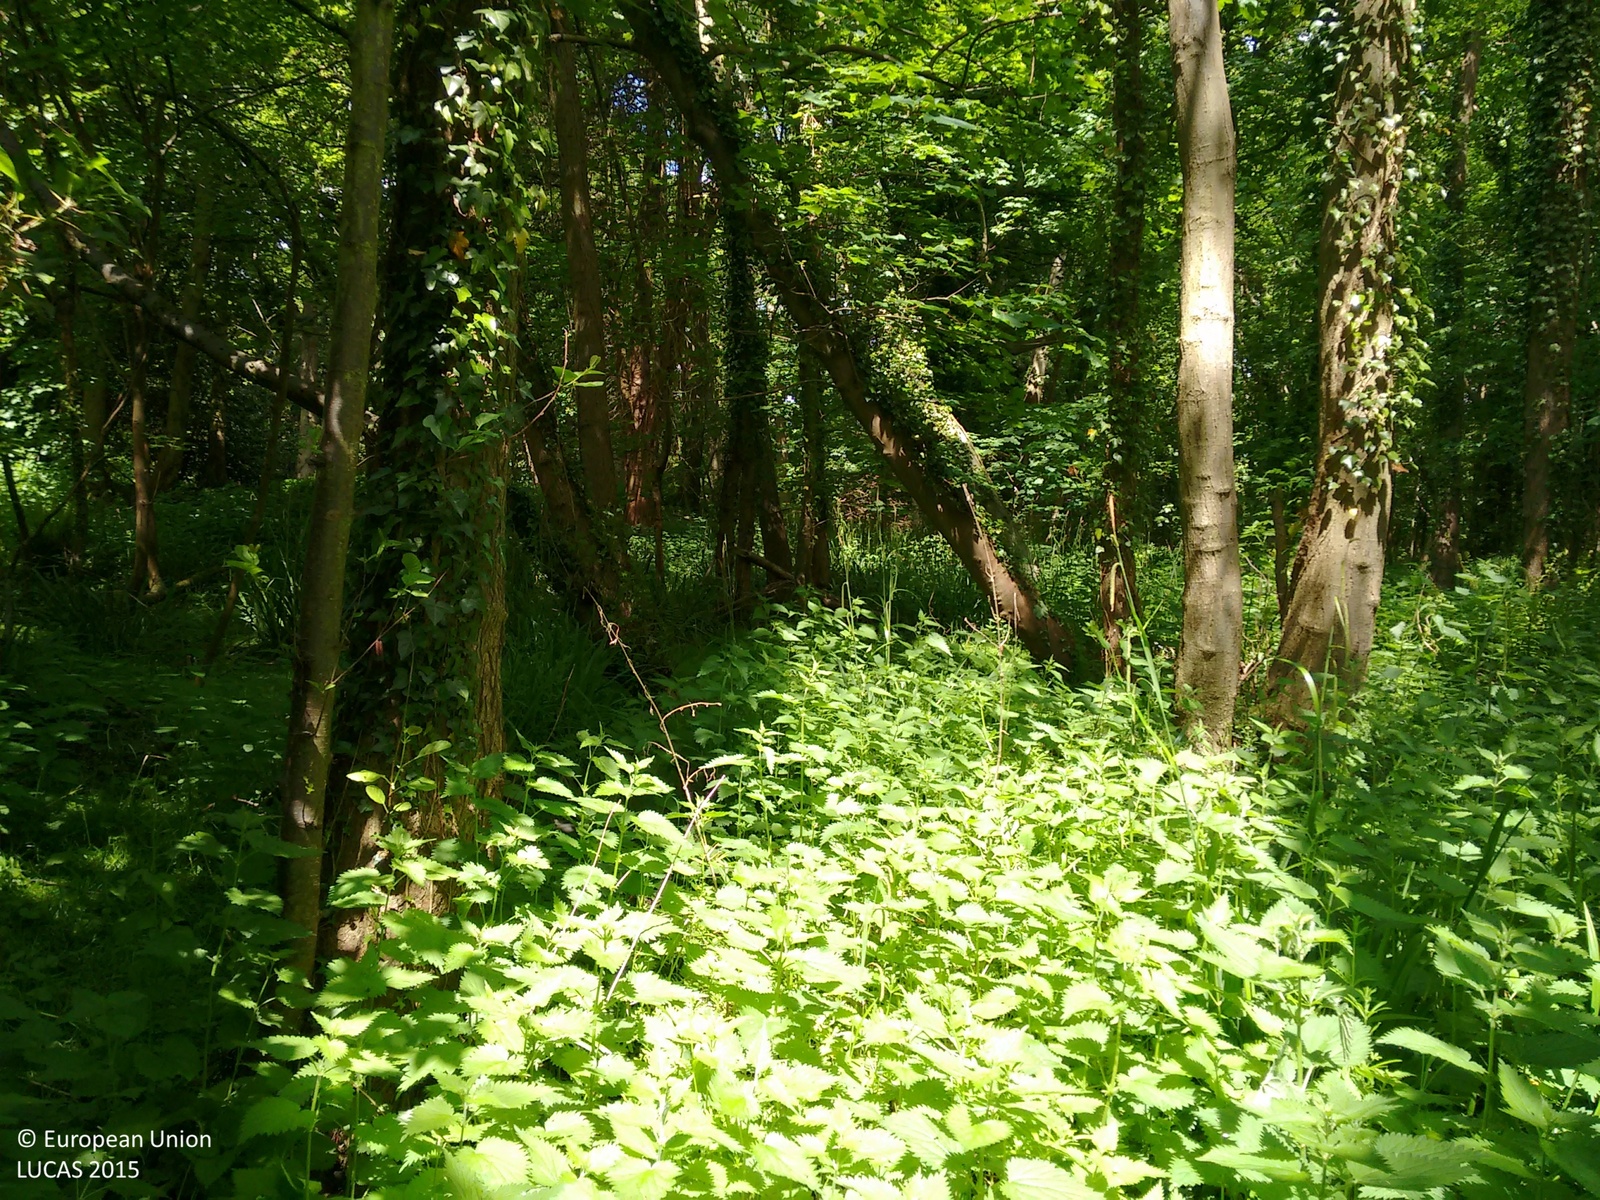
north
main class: Woodland
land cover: Broadleaved woodland
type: mesophytic deciduous forest
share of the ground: > 75 %
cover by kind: broadleaved forest trees 80 %, shrubs 10 %, herbaceous plants 10 %
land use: Amenities, museums, leisure
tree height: > 5 m
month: May
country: GB
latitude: 52.0891
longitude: -0.3257
